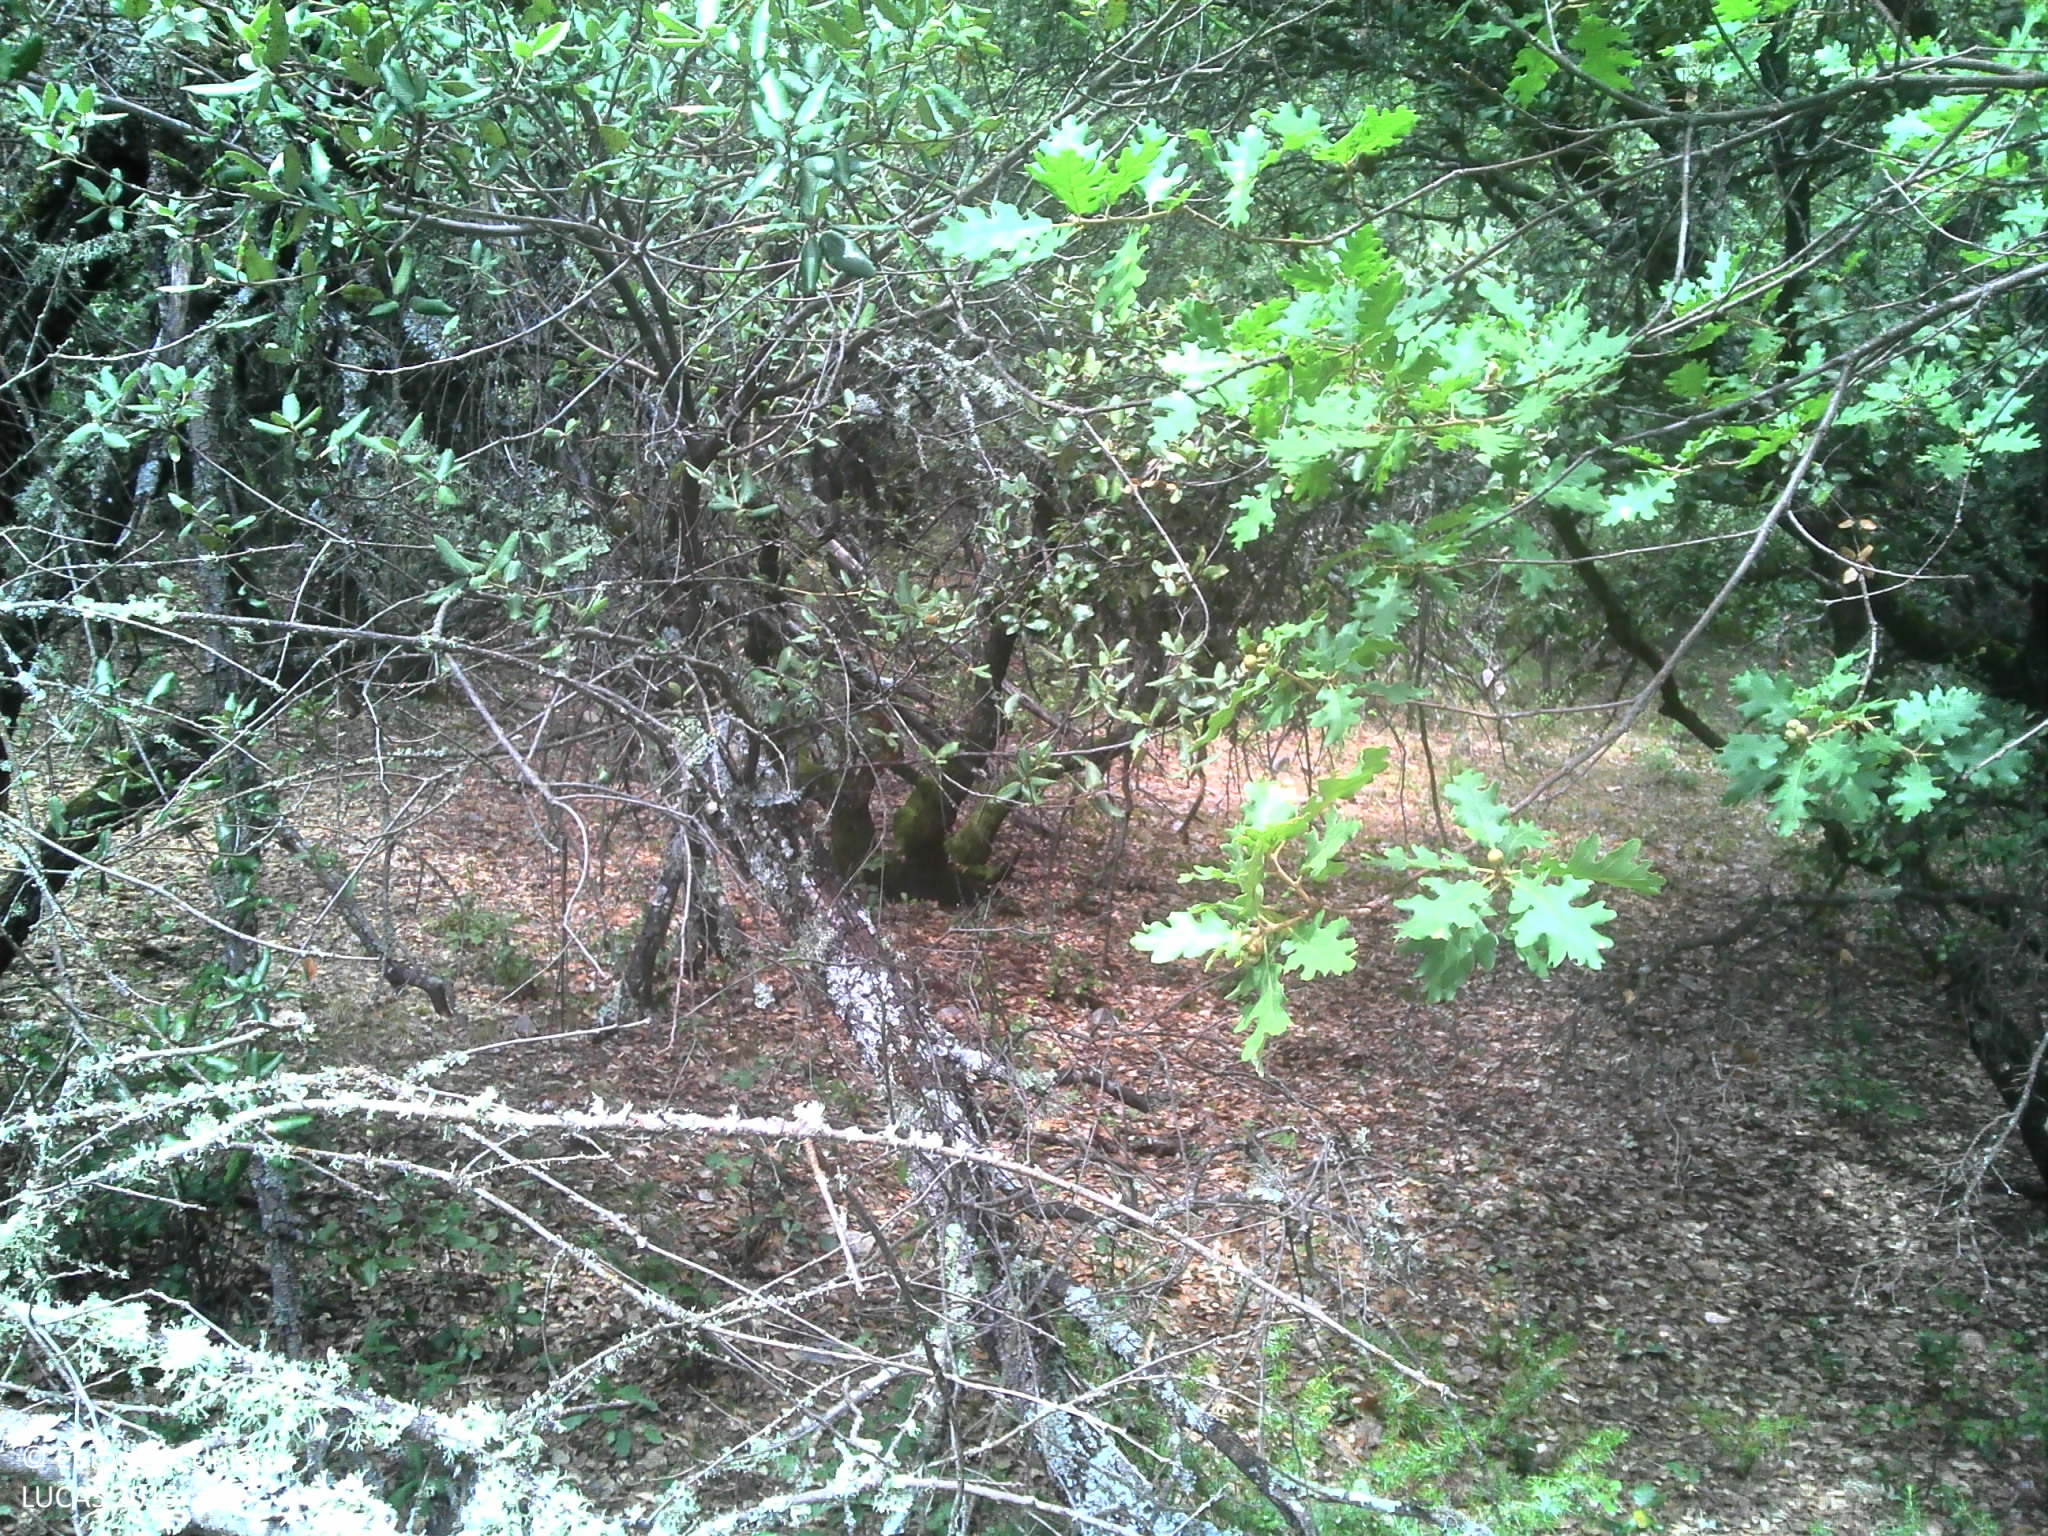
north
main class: Woodland
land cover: Broadleaved woodland
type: thermophilous deciduous forest
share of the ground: 50 - 75 %
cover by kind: broadleaved forest trees 60 %, herbaceous plants 25 %, unconsolidated bare surface 15 %
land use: Semi-natural and natural areas not in use
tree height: > 5 m
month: July
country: FR
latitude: 44.0046
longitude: 5.6057
